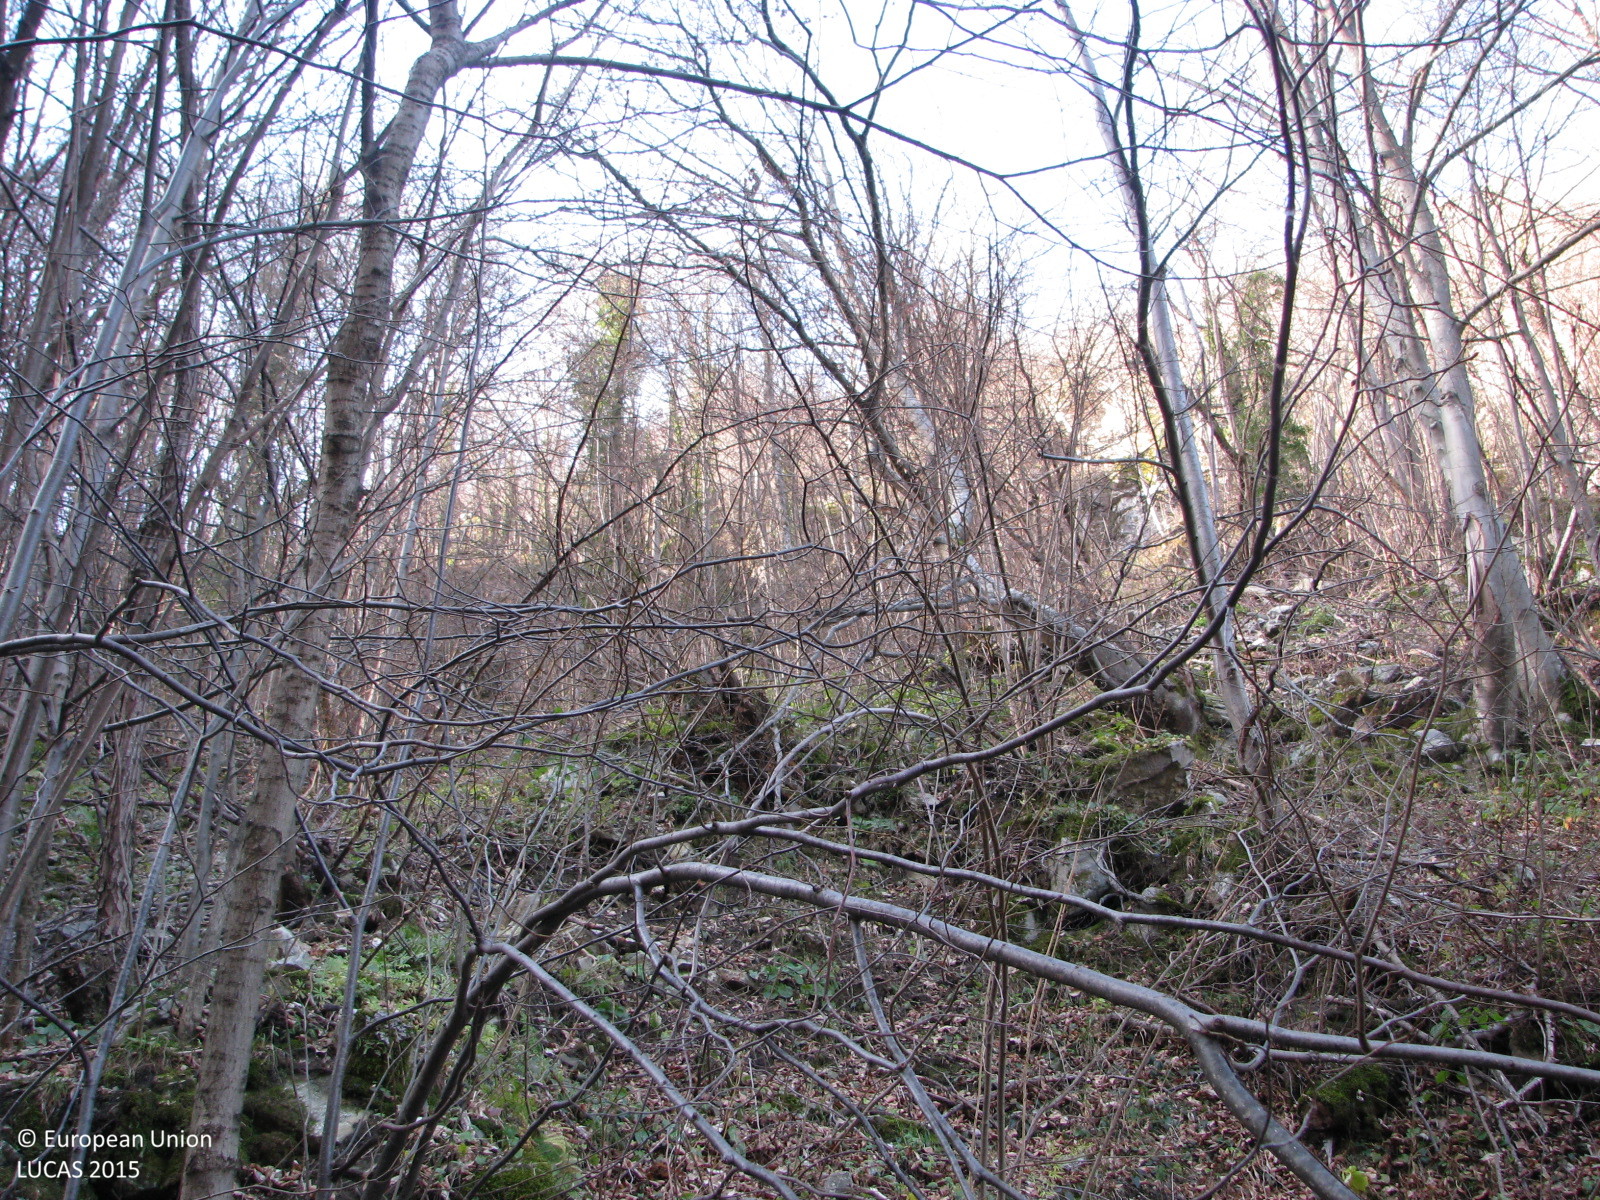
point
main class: Woodland
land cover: Broadleaved woodland
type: mesophytic deciduous forest
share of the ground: 50 - 75 %
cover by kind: broadleaved forest trees 70 %, unconsolidated bare surface 30 %
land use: Forestry
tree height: > 5 m
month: December
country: BG
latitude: 42.1566
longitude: 23.9684
